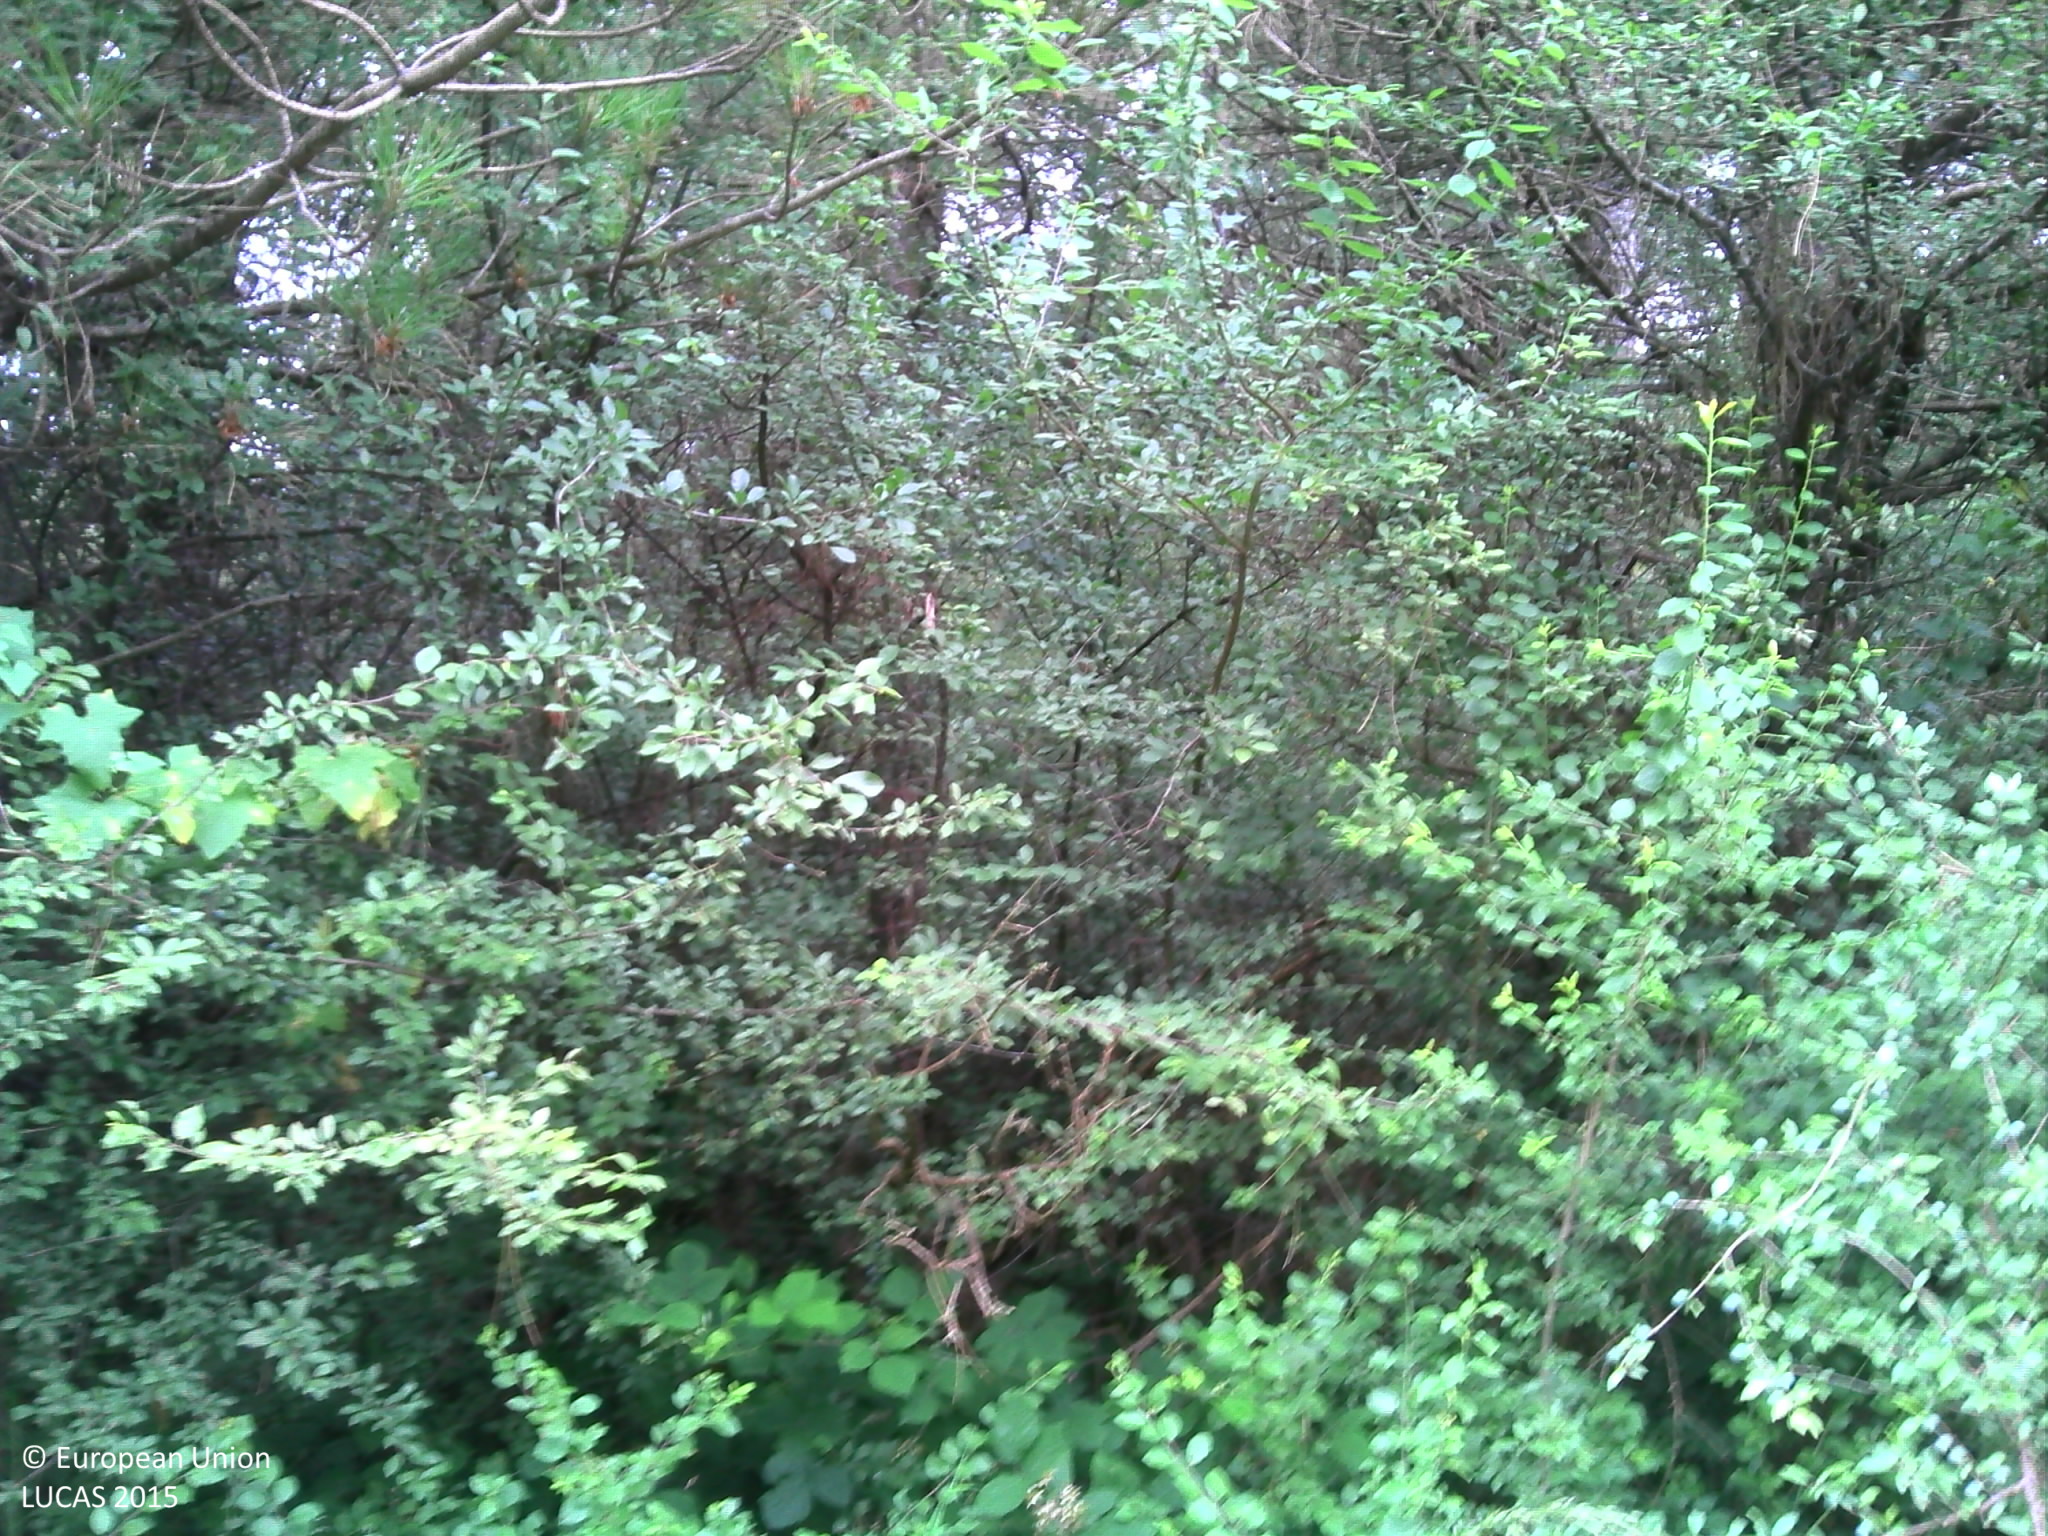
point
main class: Woodland
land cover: Pine dominated coniferous woodland
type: coniferous forest of the mediterranean region
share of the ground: > 75 %
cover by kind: coniferous forest trees 100 %
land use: Forestry
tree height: > 5 m
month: June
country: FR
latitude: 43.4103
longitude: 2.0408
